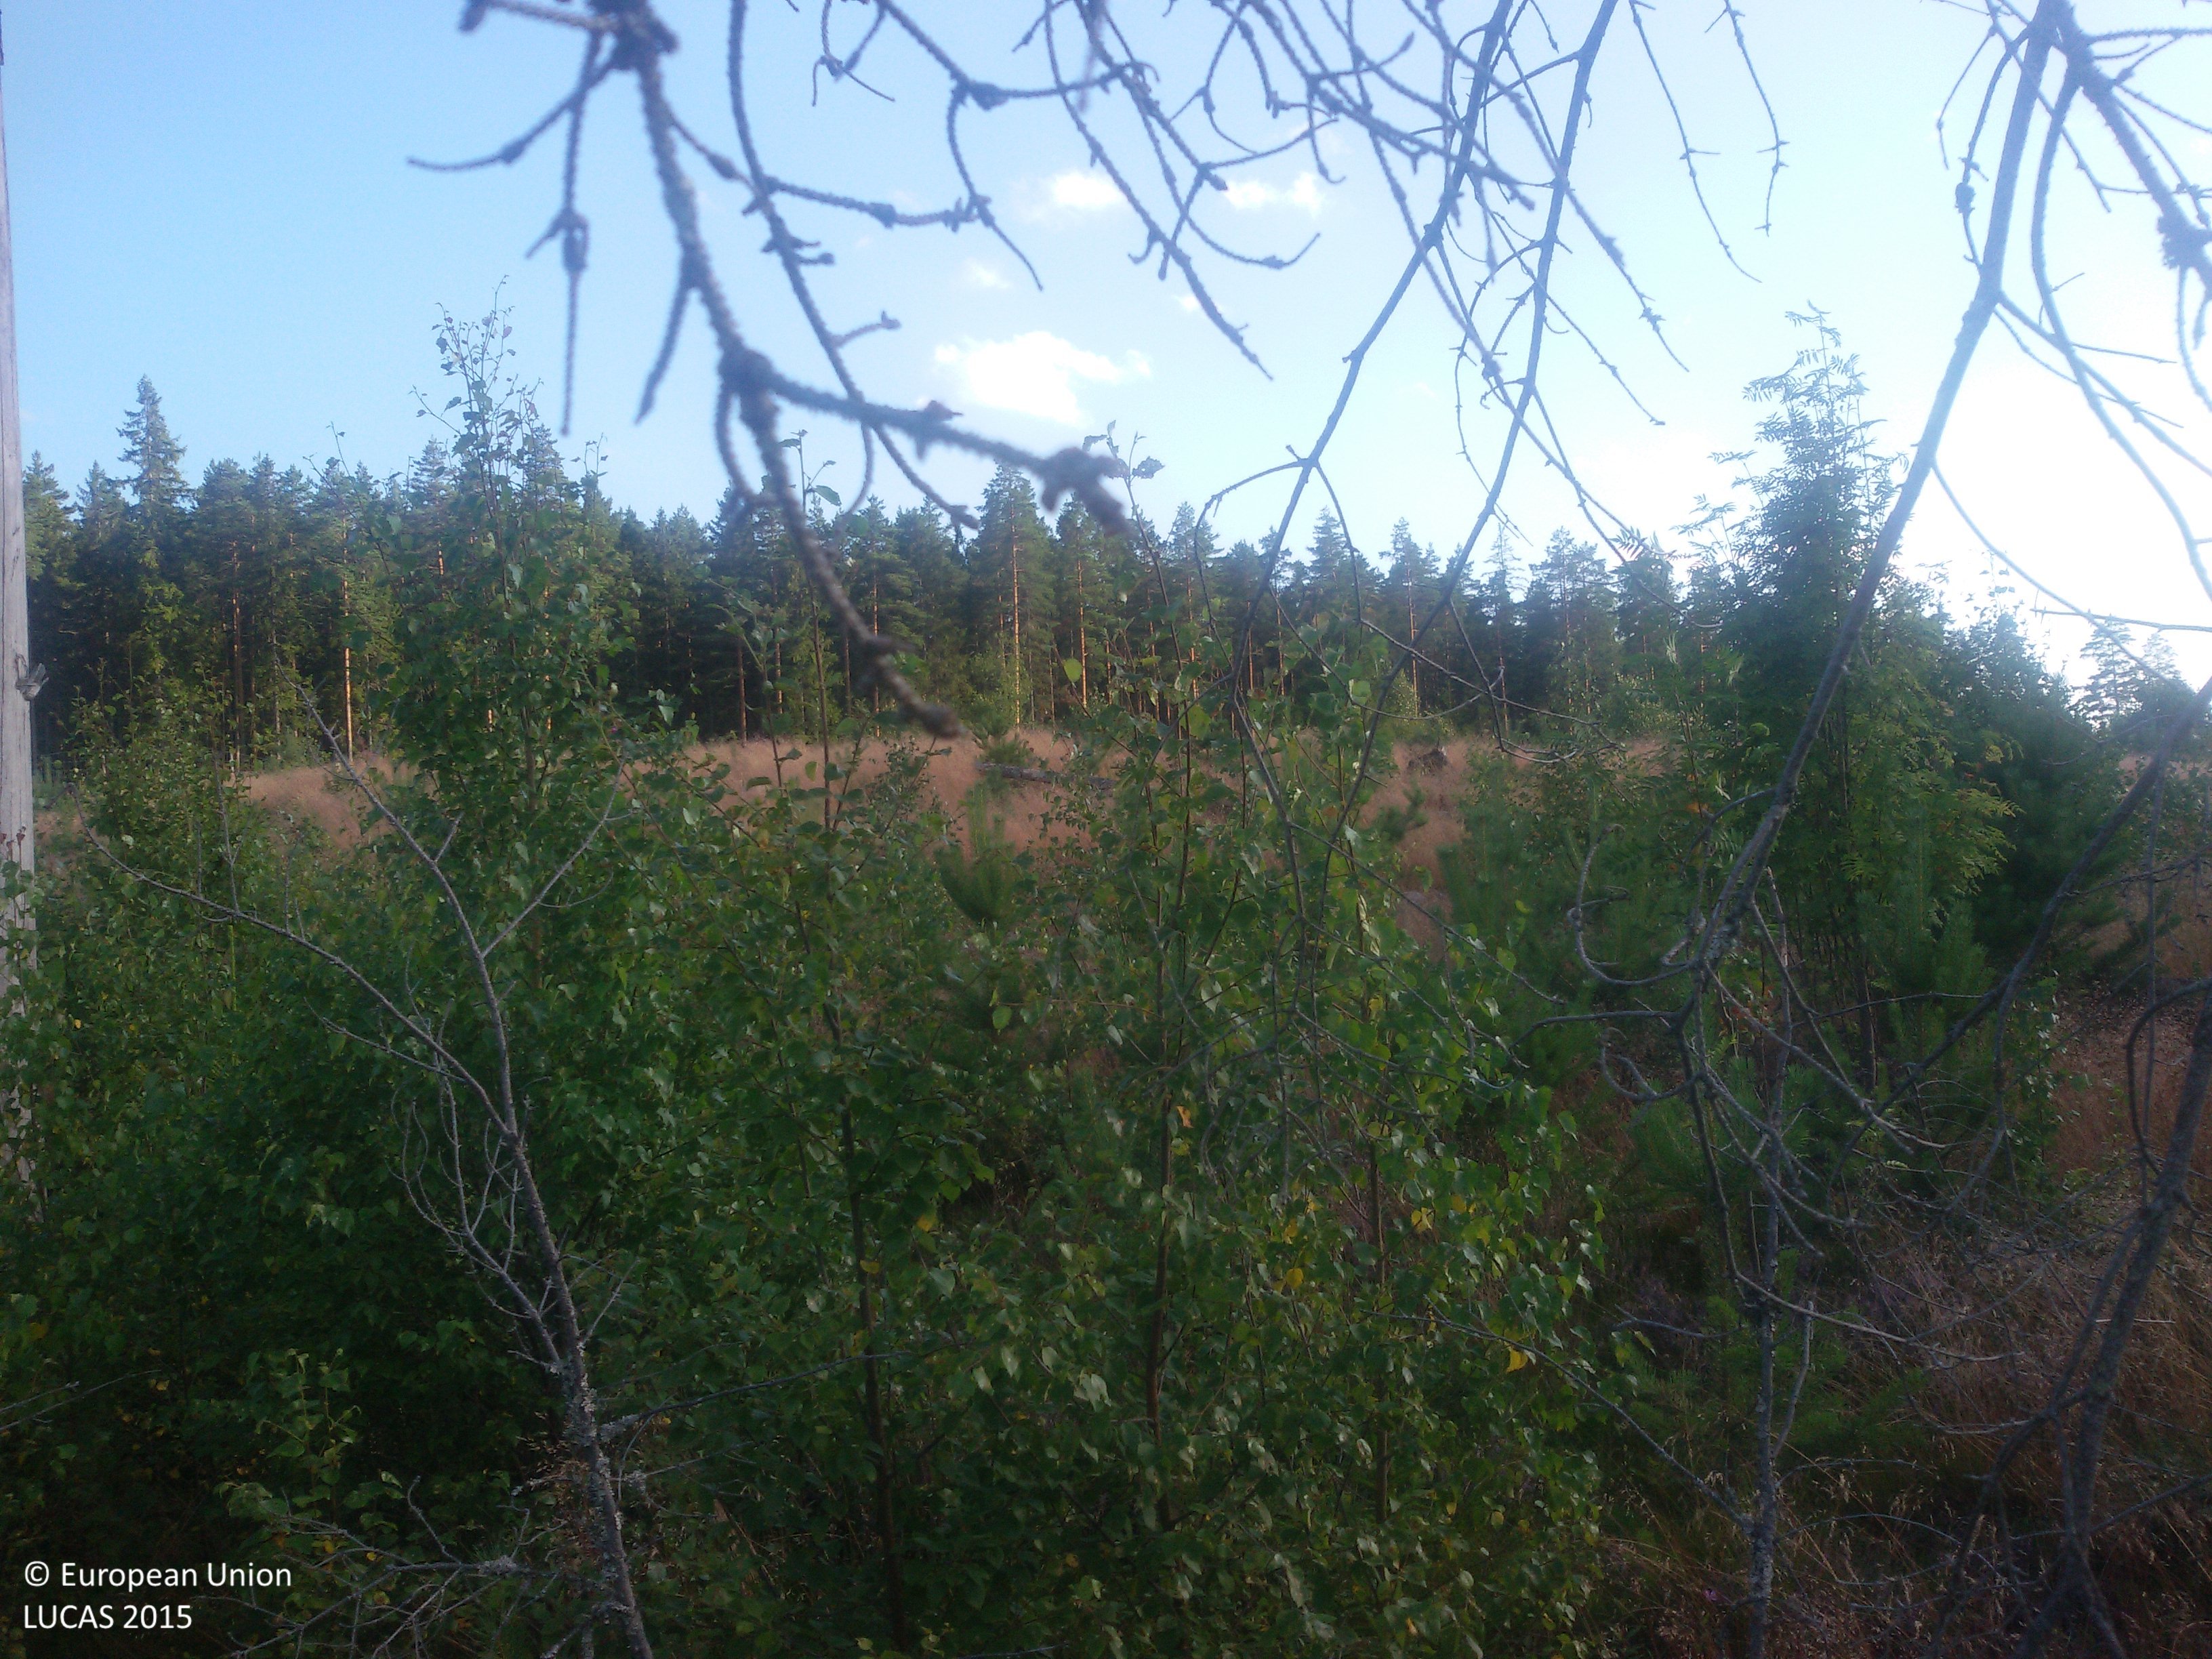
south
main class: Woodland
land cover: Pine dominated mixed woodland
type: boreal forest
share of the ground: > 75 %
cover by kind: broadleaved forest trees 45 %, coniferous forest trees 30 %, herbaceous plants 25 %
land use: Forestry
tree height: < 5 m
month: August
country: SE
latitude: 60.6183
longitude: 16.6942
